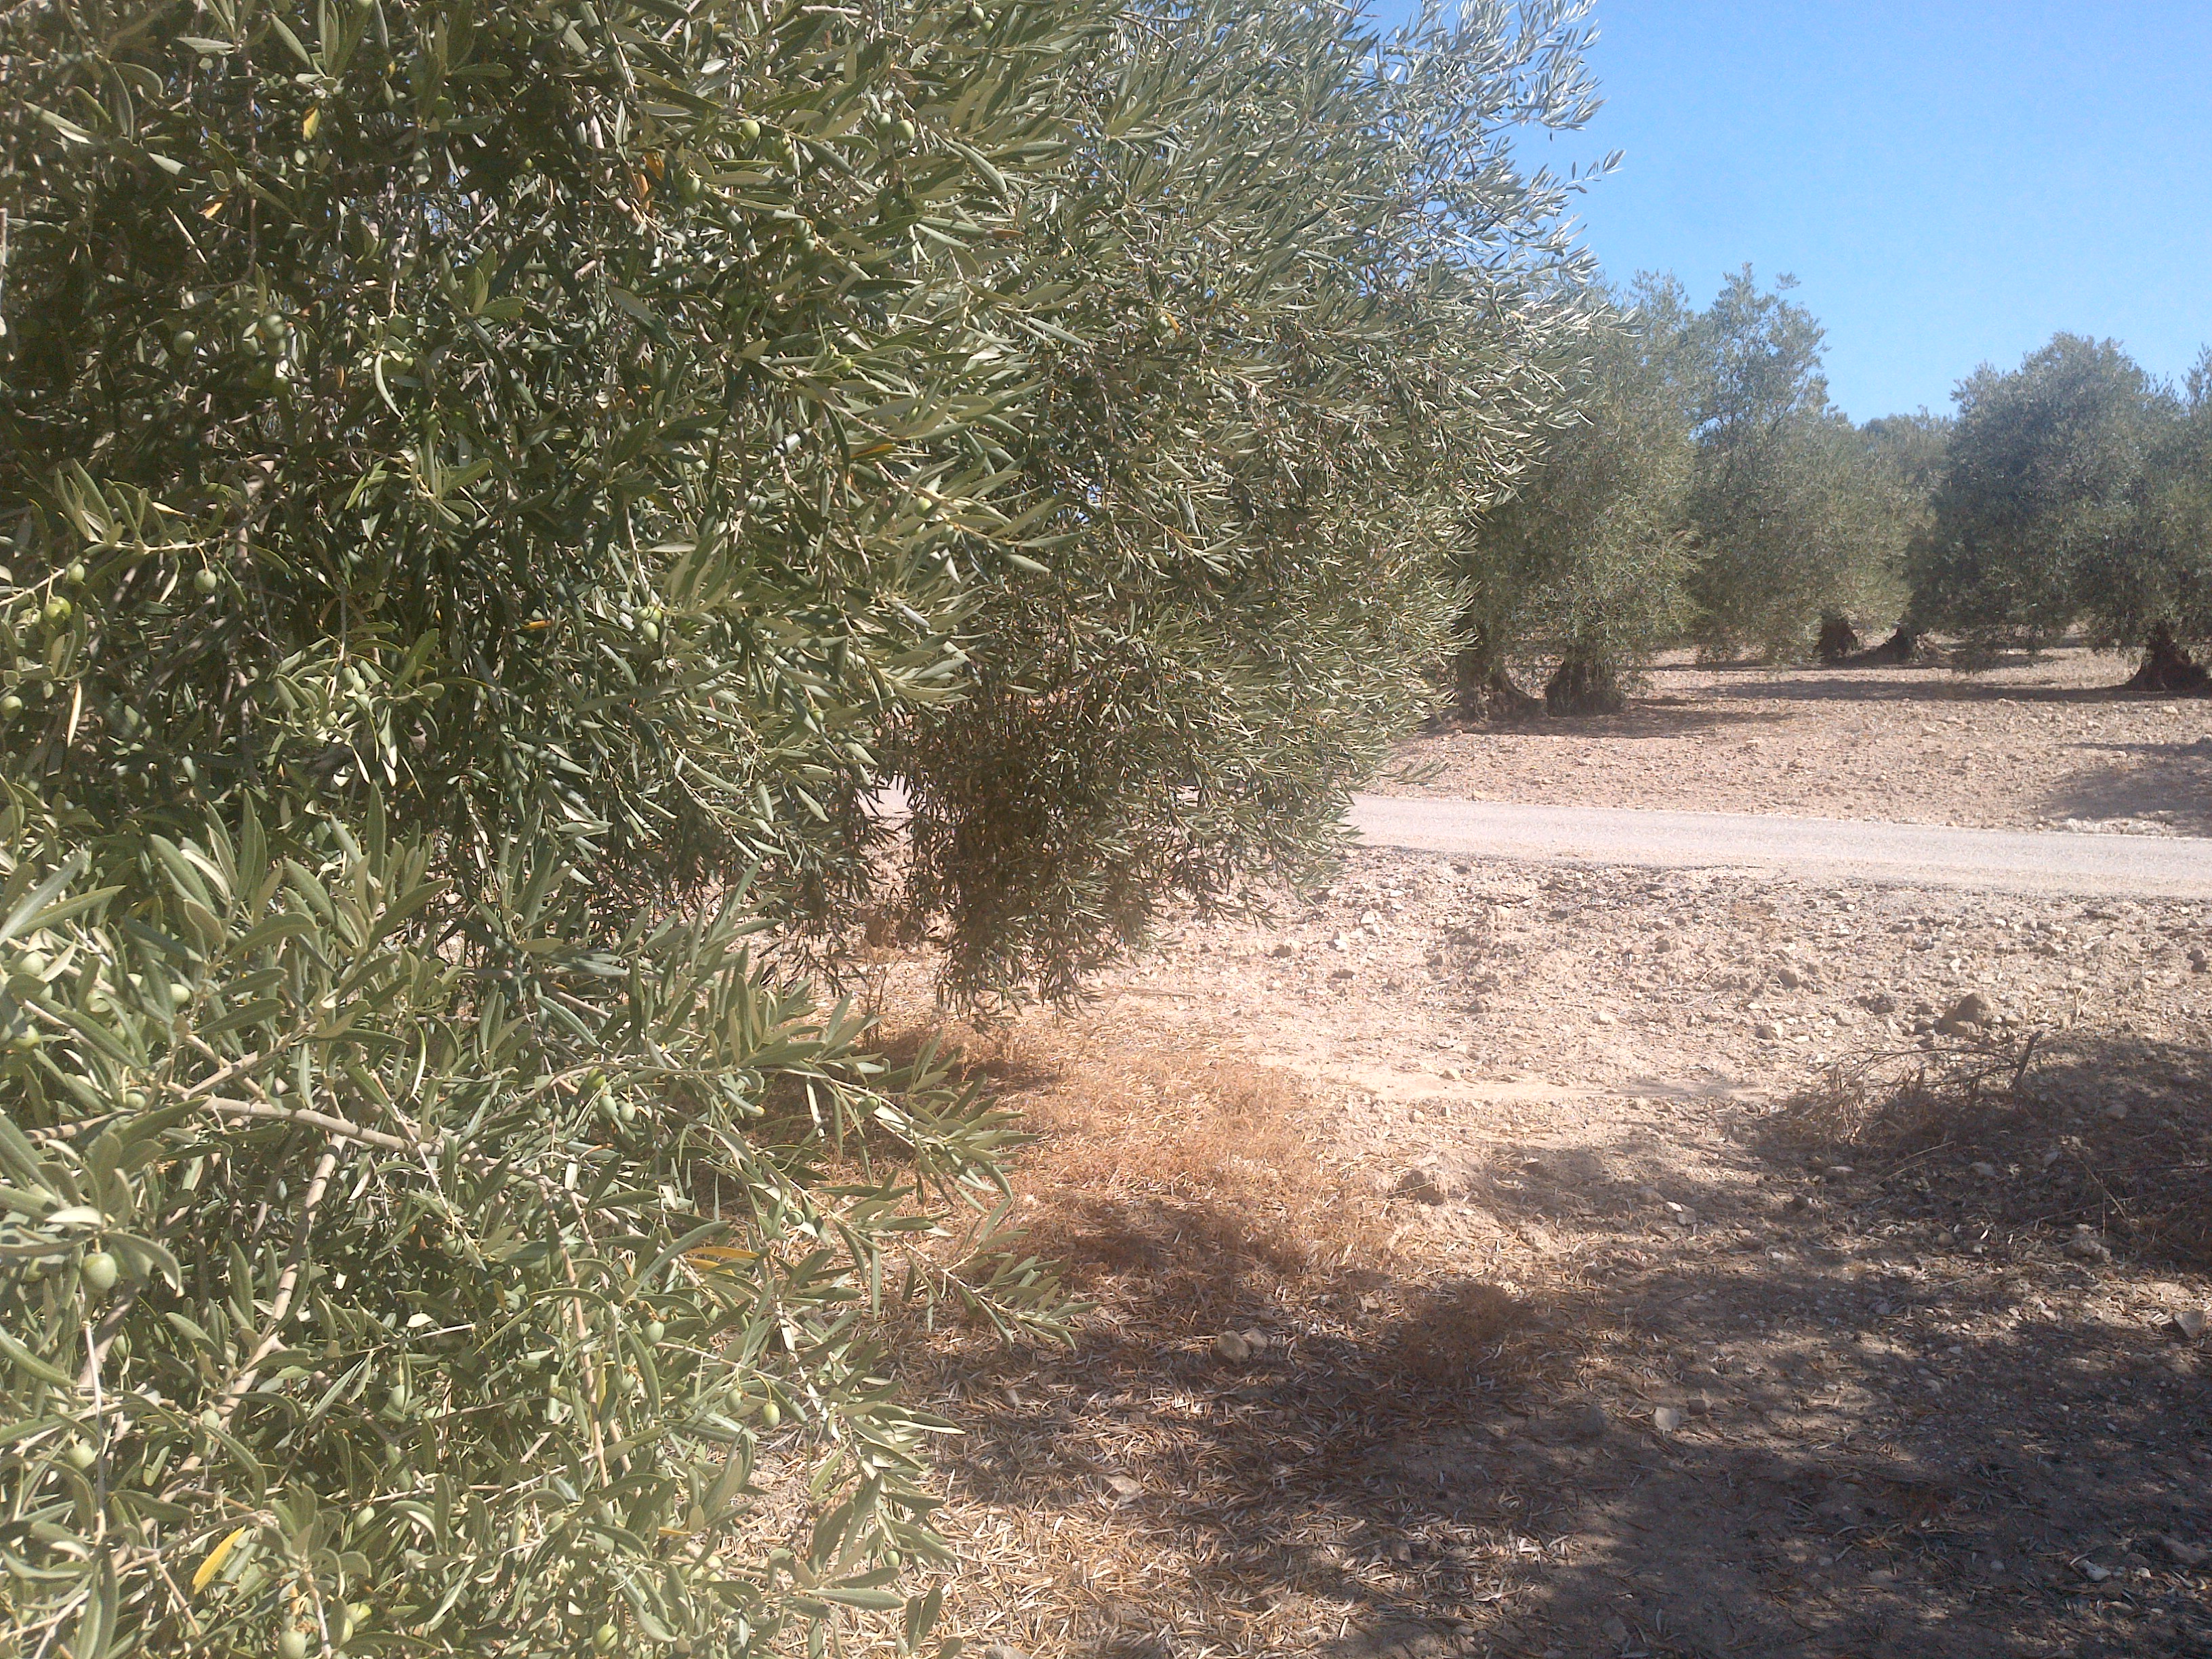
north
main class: Cropland
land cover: Olive groves
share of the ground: 50 - 75 %
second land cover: Other bare soil
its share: > 75 %
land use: Agriculture (excluding fallow land and kitchen gardens)
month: July
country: ES
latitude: 37.4041
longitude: -4.8400
